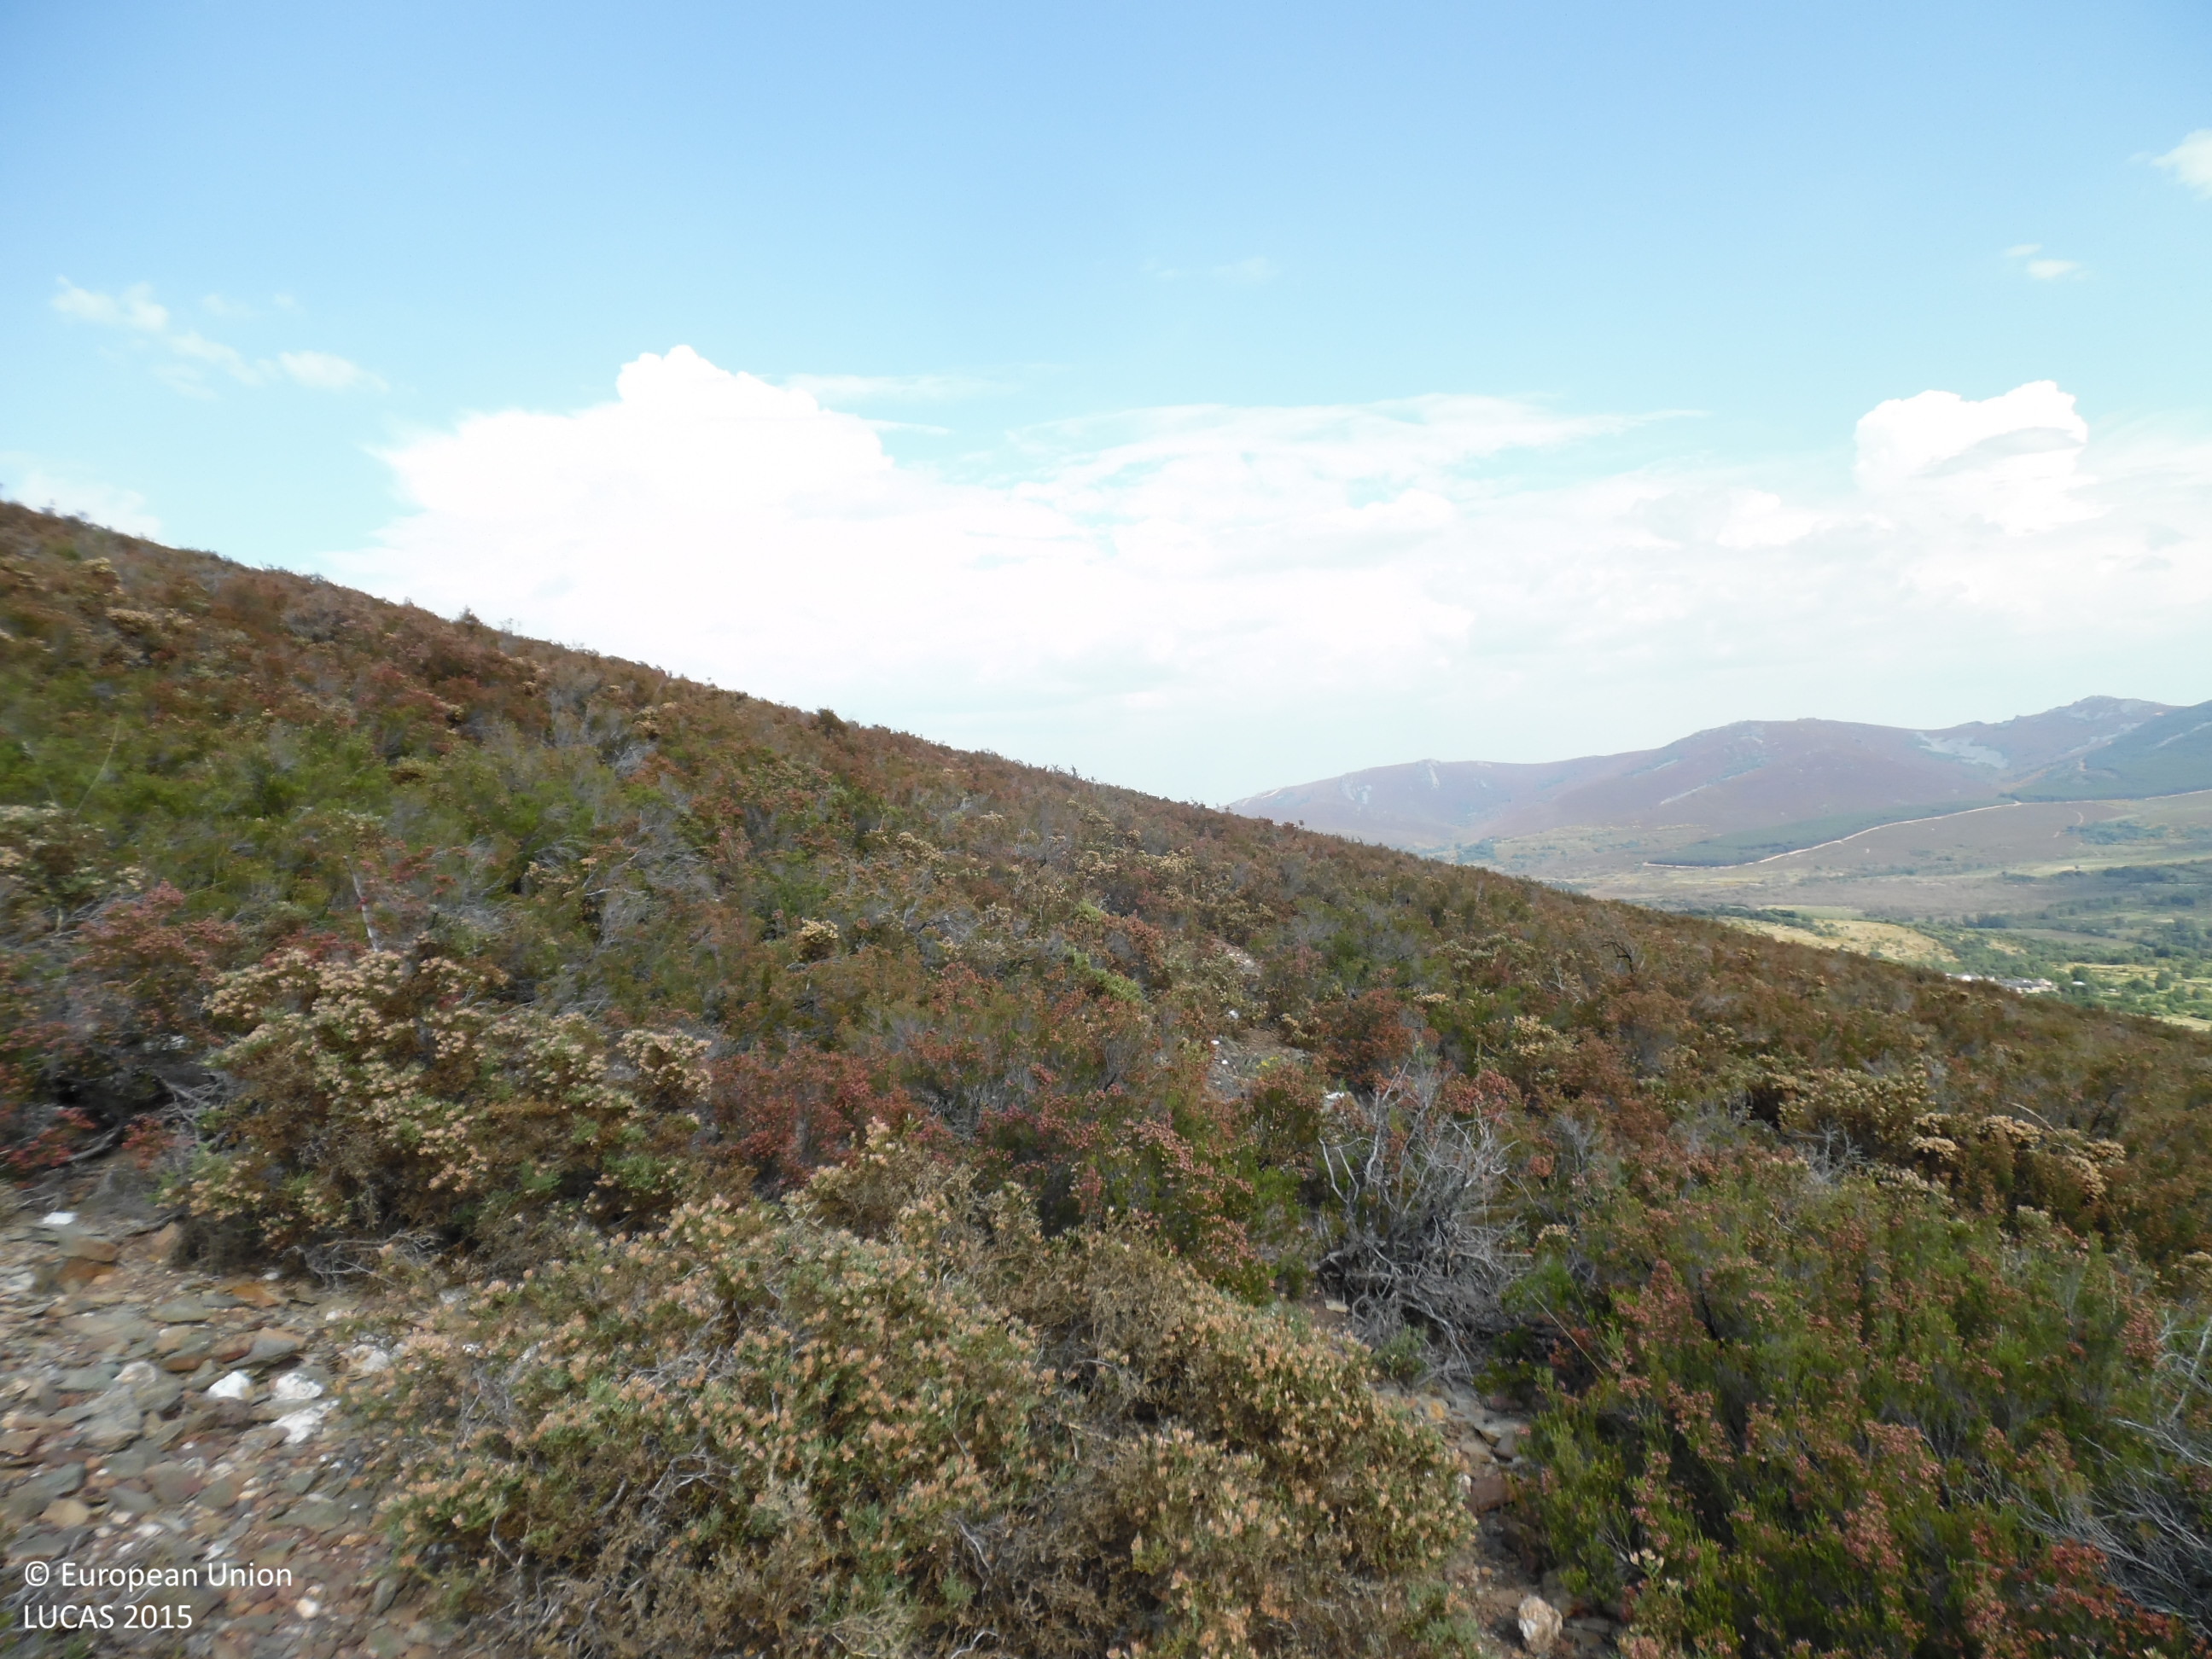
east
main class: Shrubland
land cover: Shrubland without tree cover
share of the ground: > 75 %
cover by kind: shrubs 90 %, unconsolidated bare surface 10 %
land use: Semi-natural and natural areas not in use
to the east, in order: Shrubland without tree cover; Rocks and stones; Shrubland without tree cover
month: June
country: ES
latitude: 42.2642
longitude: -6.3922
